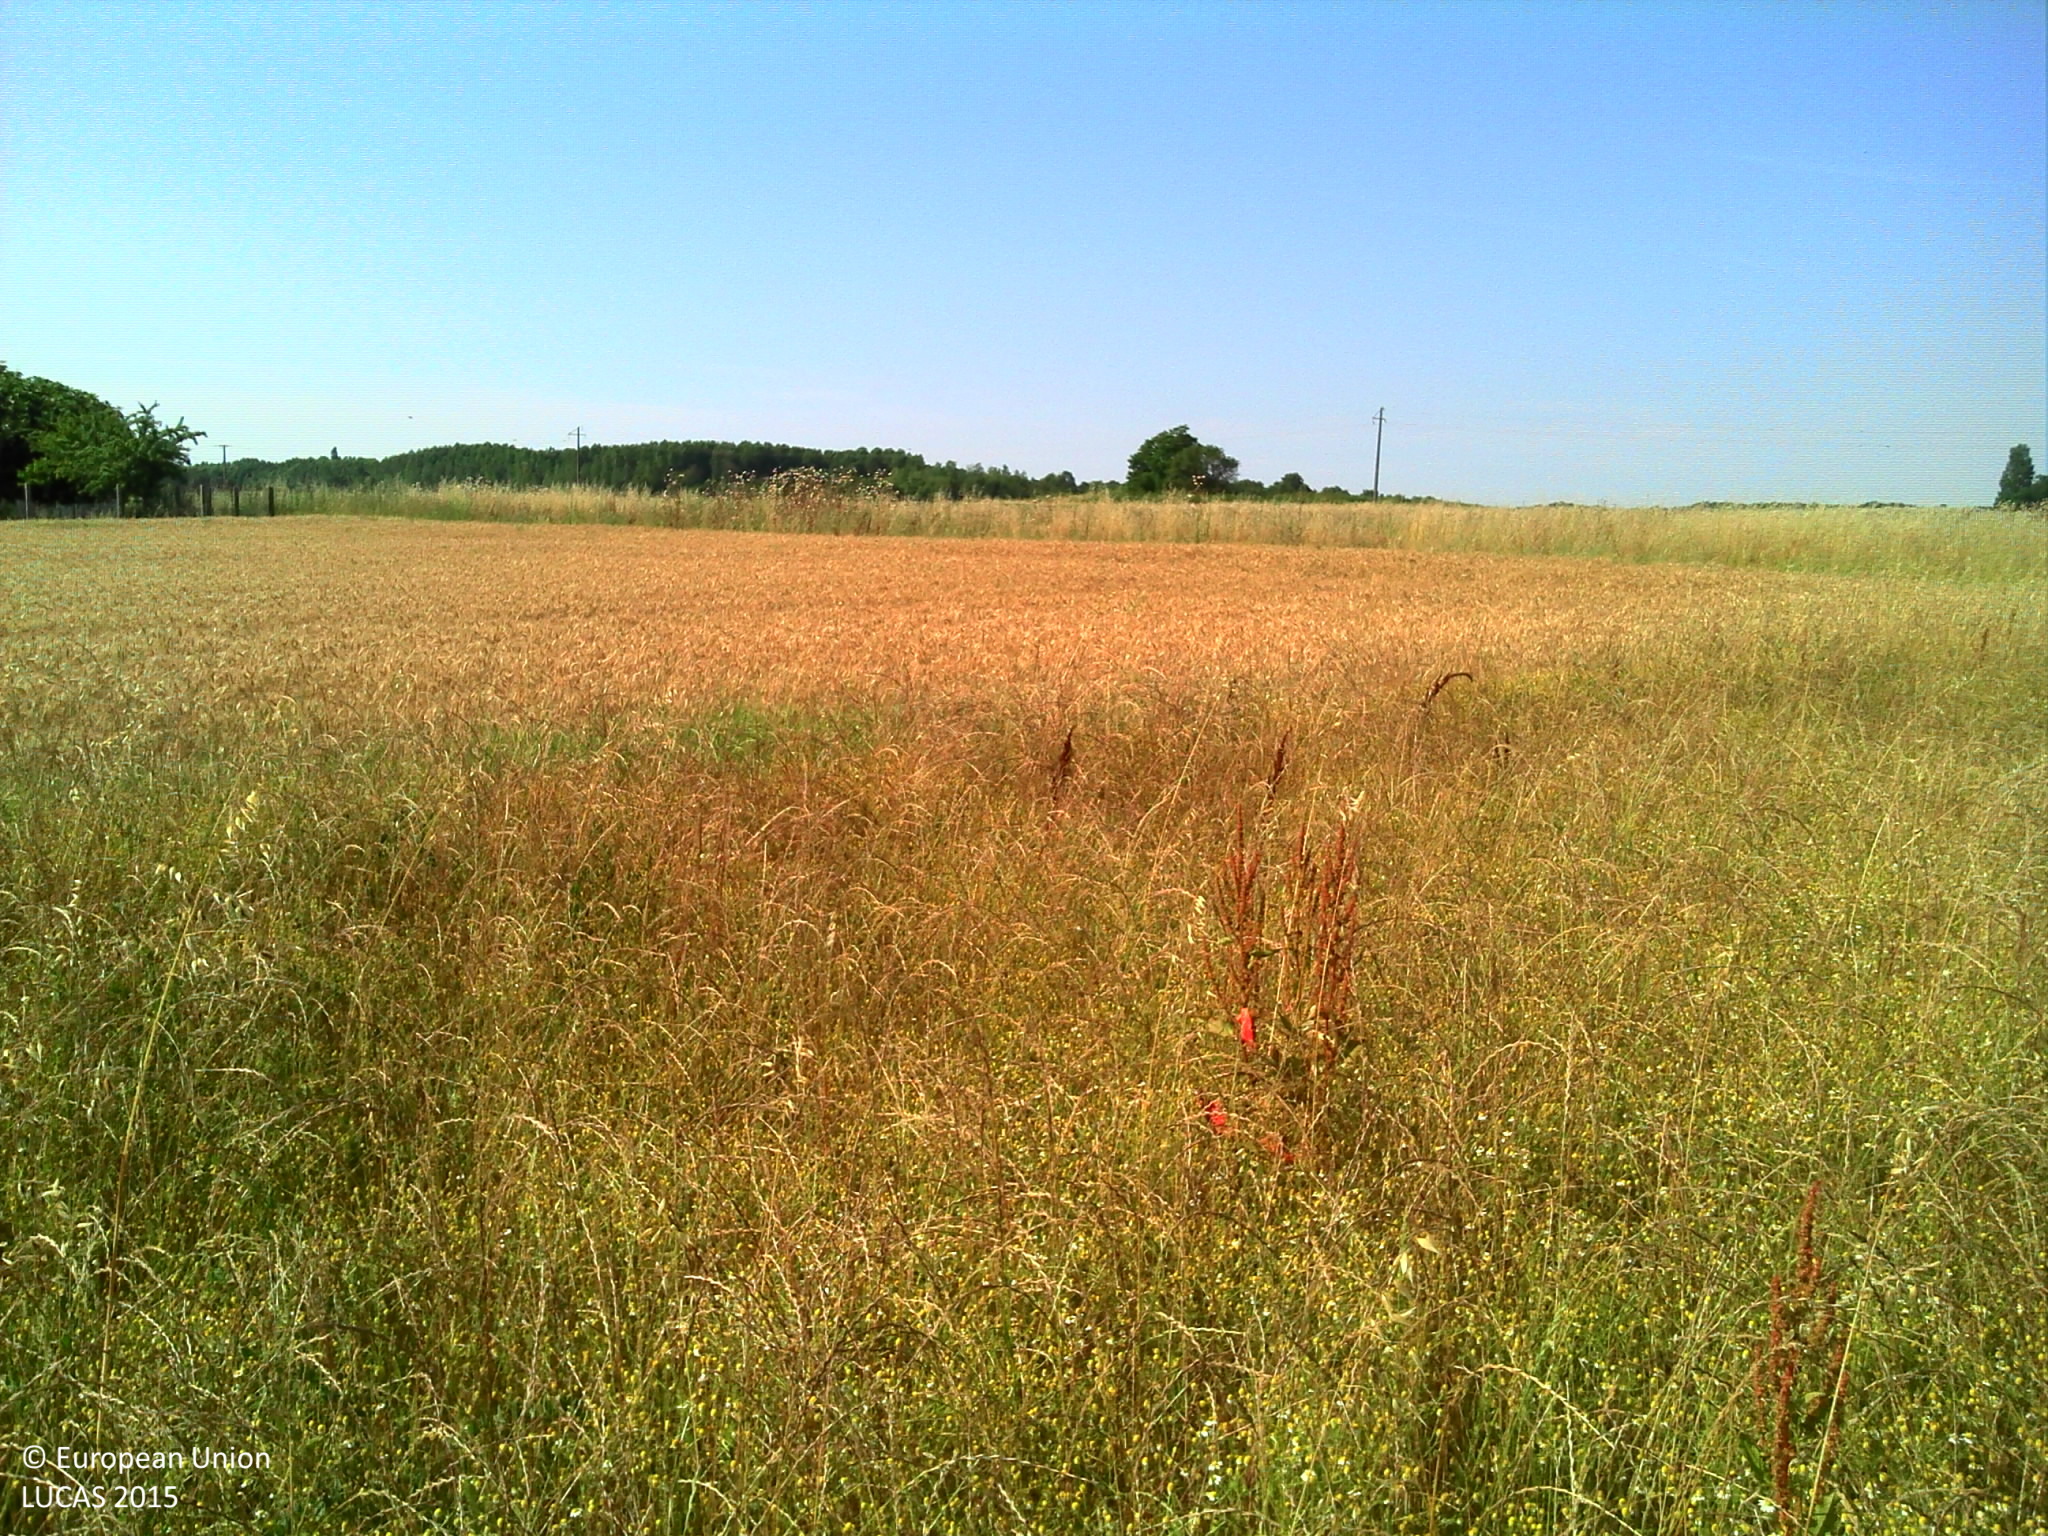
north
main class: Grassland
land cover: Grassland without tree/shrub cover
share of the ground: > 75 %
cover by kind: herbaceous plants 100 %
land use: Agriculture (excluding fallow land and kitchen gardens)
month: June
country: FR
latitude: 45.7314
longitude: -0.9632
